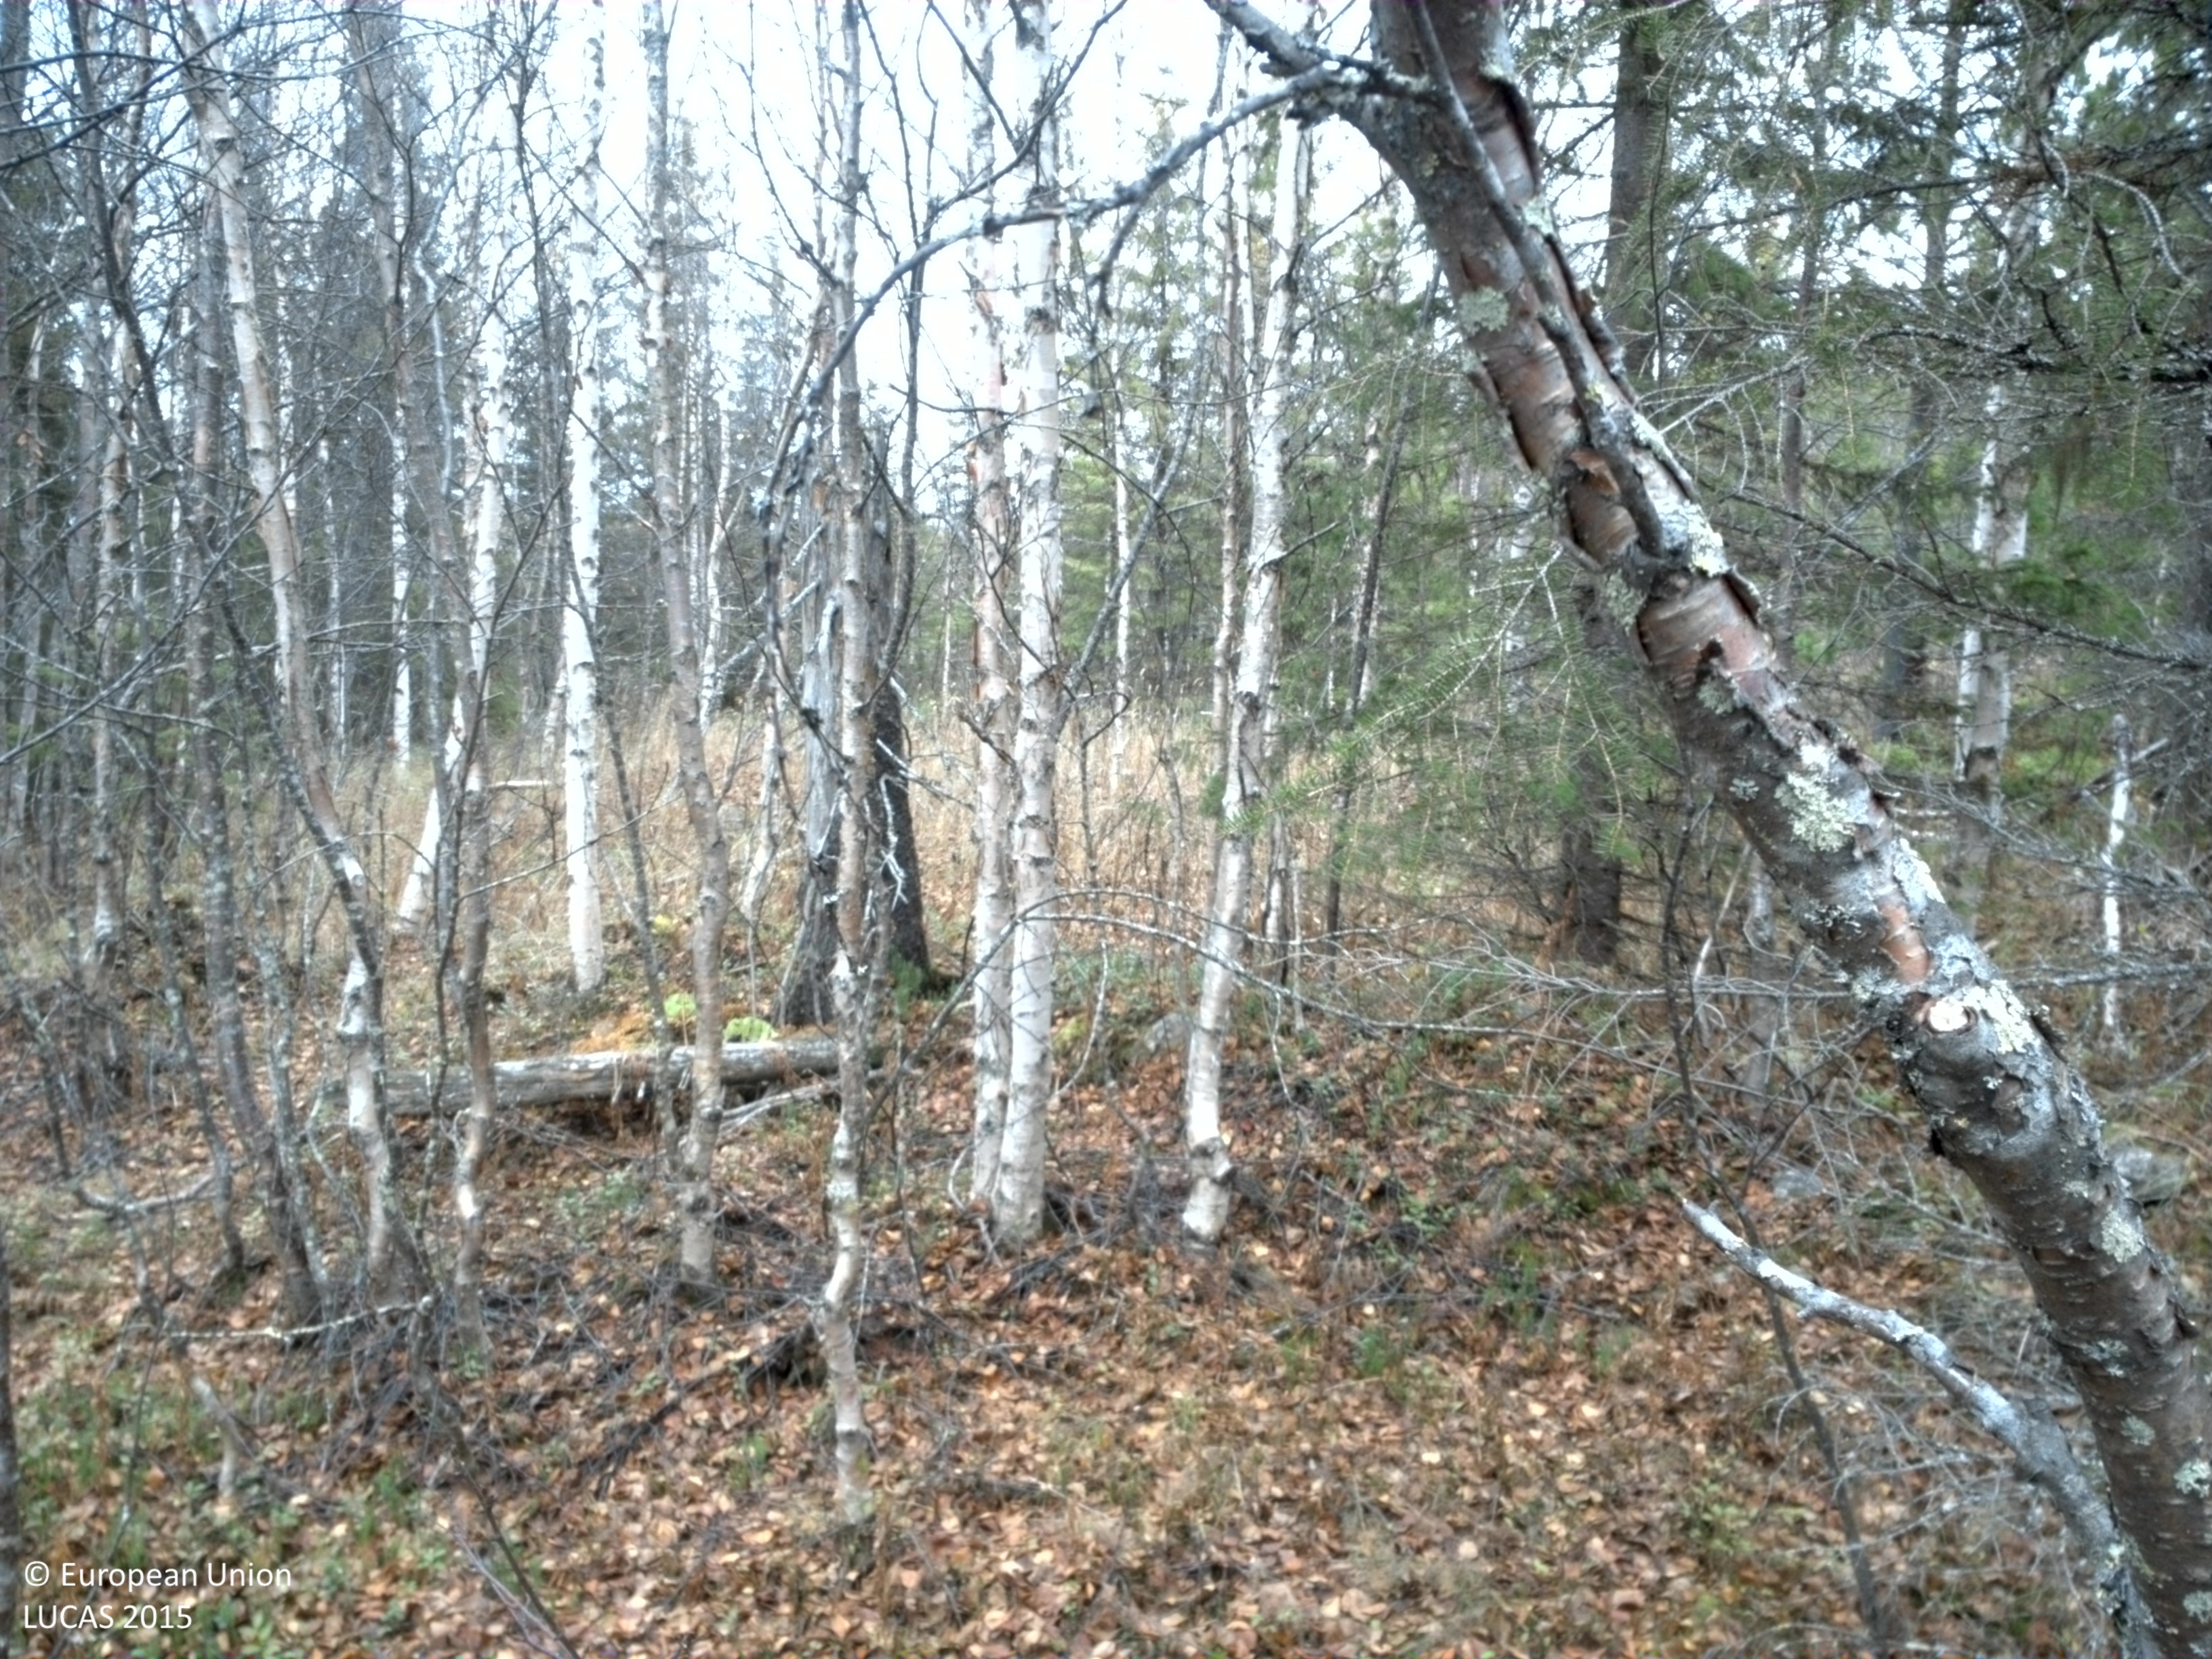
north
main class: Woodland
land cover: Spruce dominated mixed woodland
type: boreal forest
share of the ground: 50 - 75 %
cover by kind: broadleaved forest trees 35 %, unconsolidated bare surface 20 %, coniferous forest trees 15 %, herbaceous plants 15 %, shrubs 10 %, lichens and mosses 5 %
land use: Forestry
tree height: > 5 m
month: October
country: SE
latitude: 64.9902
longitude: 16.9385
